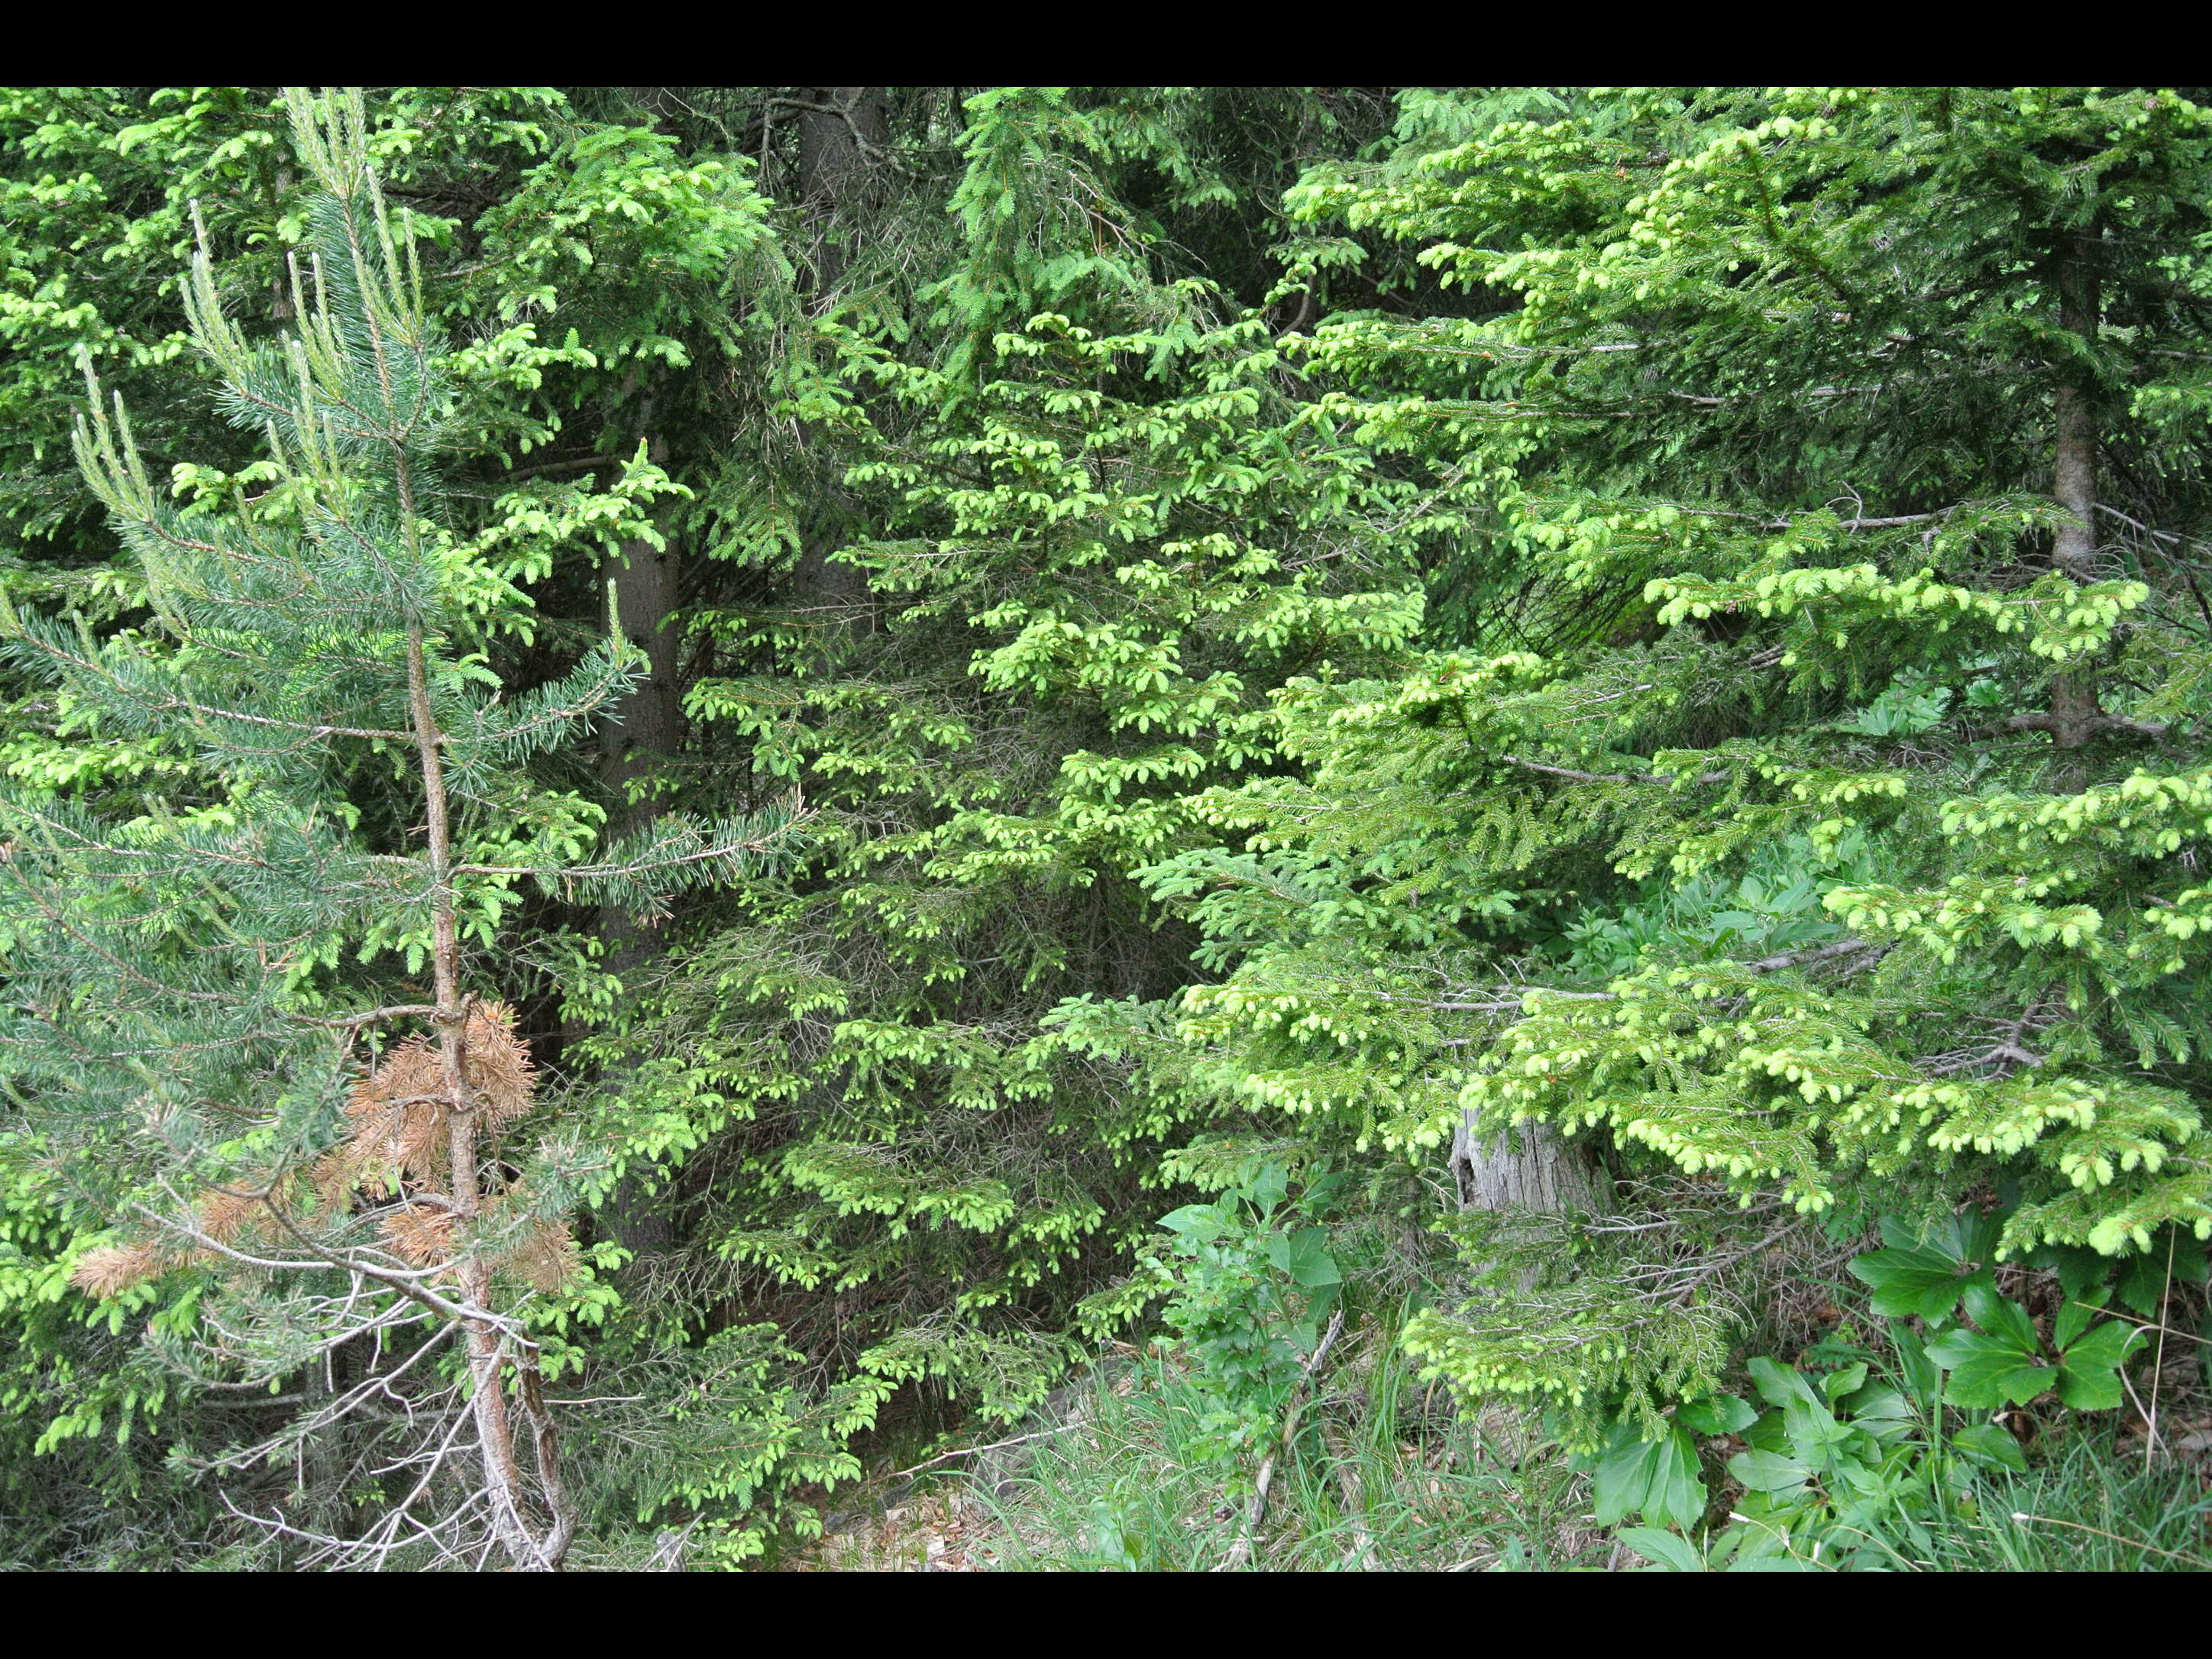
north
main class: Woodland
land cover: Spruce dominated coniferous woodland
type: alpine coniferous forest
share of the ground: > 75 %
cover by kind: coniferous forest trees 90 %, herbaceous plants 10 %
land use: Forestry
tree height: > 5 m
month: June
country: AT
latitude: 47.9281
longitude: 15.7710
